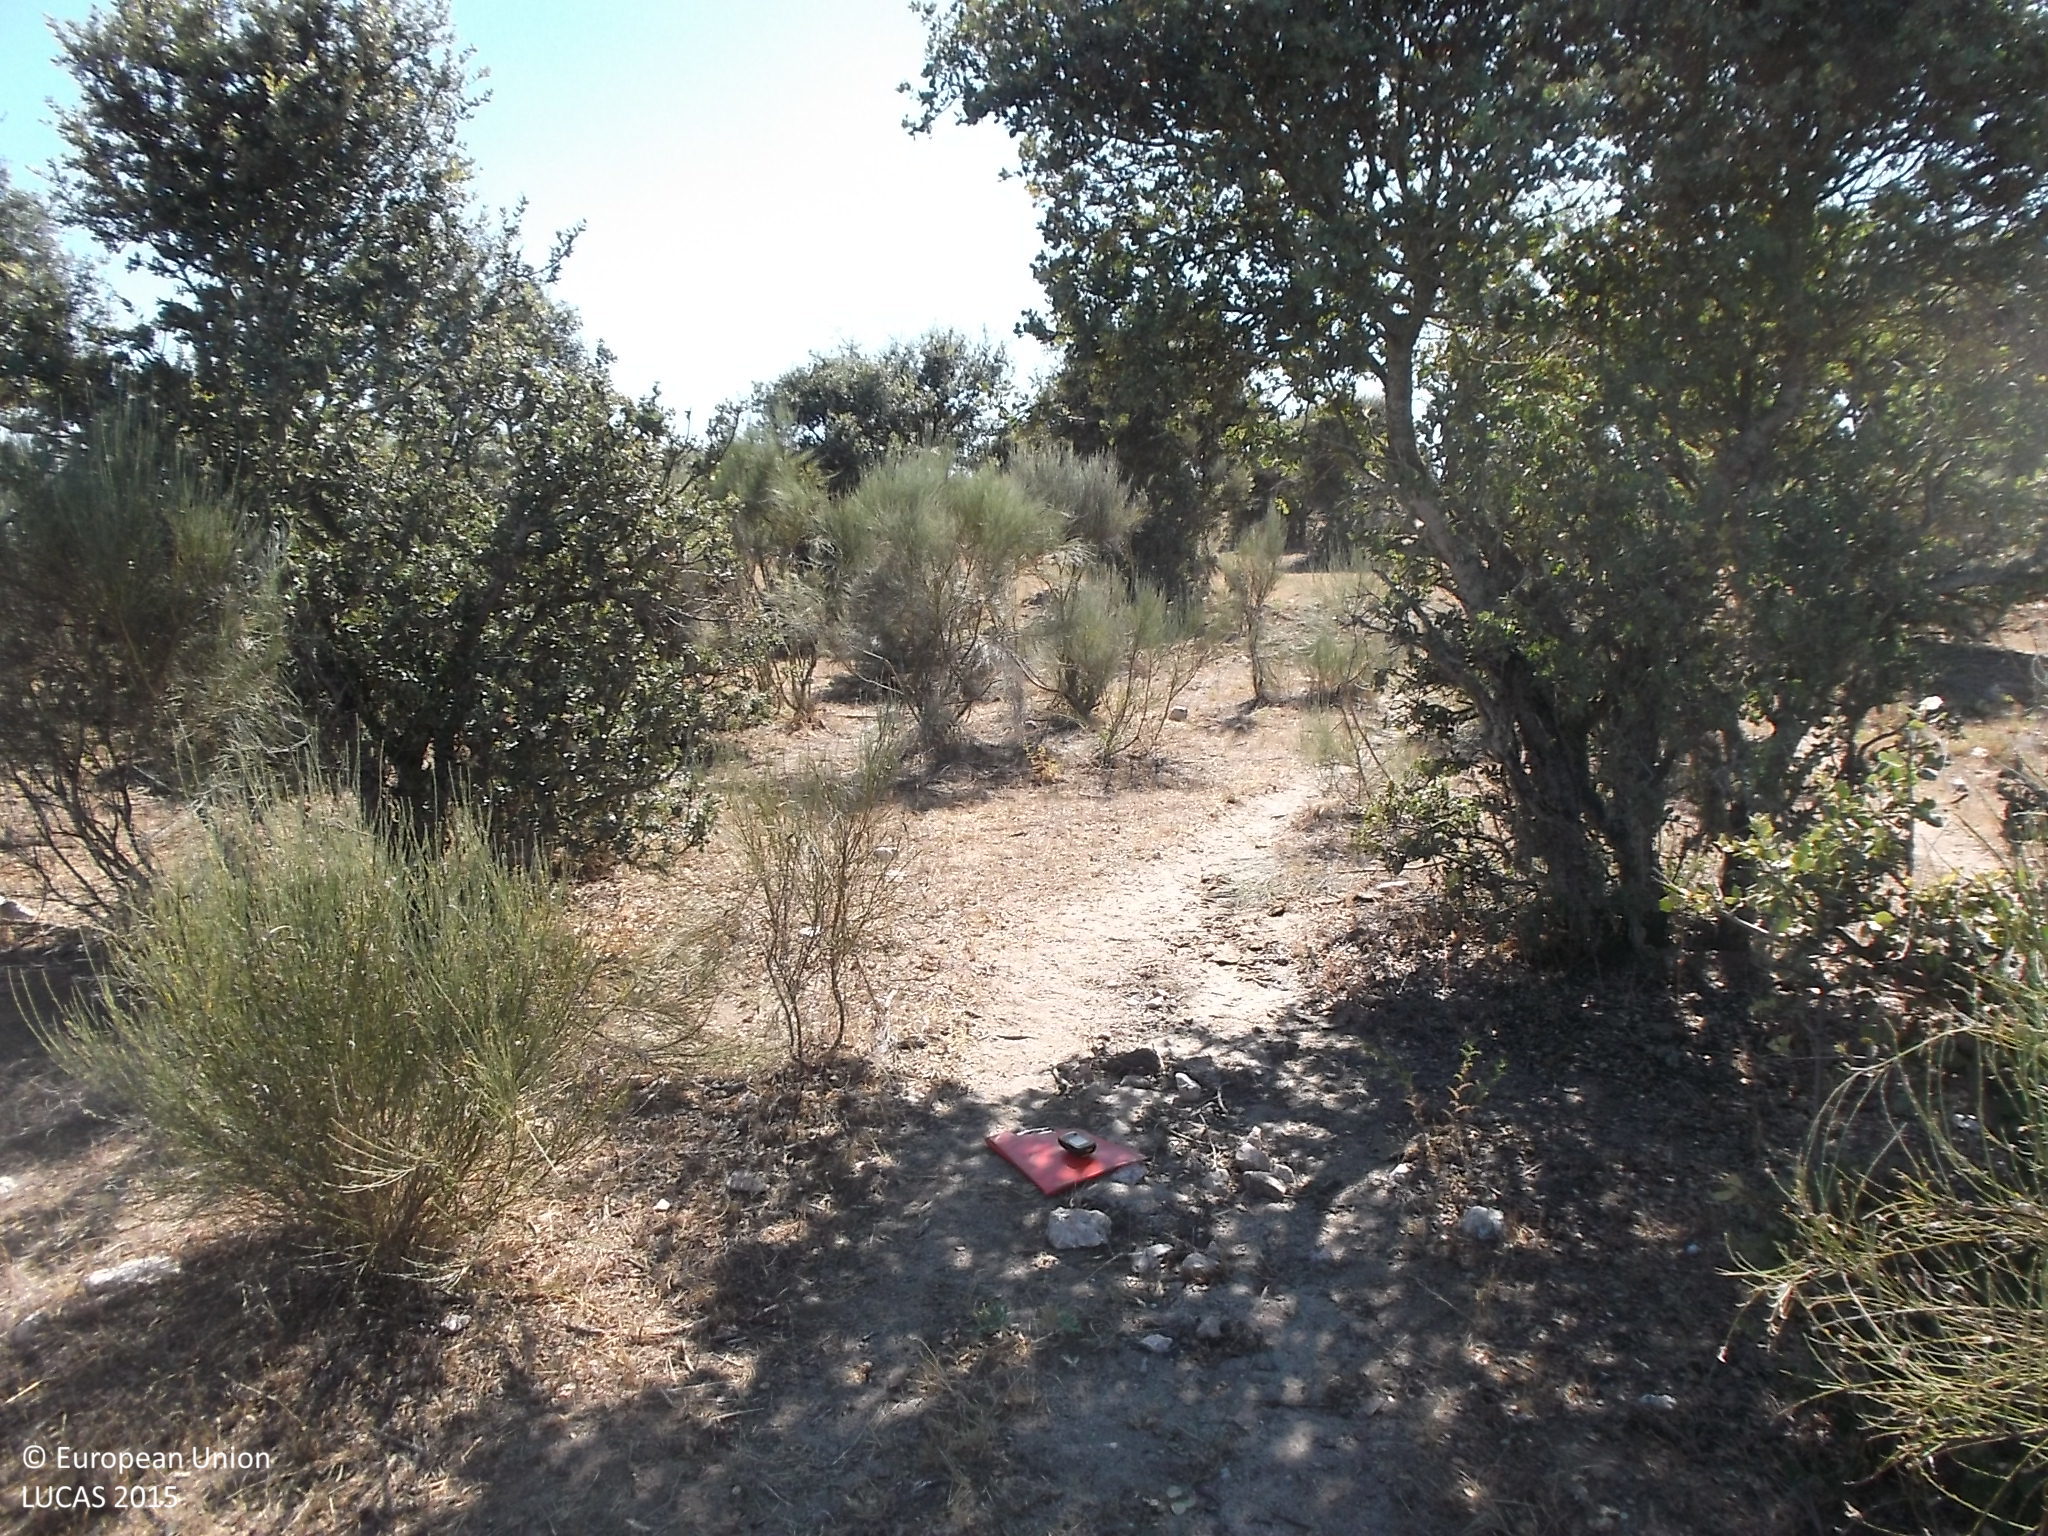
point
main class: Shrubland
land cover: Shrubland without tree cover
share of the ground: 50 - 75 %
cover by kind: shrubs 70 %, herbaceous plants 30 %
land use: Agriculture (excluding fallow land and kitchen gardens)
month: July
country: ES
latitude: 40.7972
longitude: -6.7987
